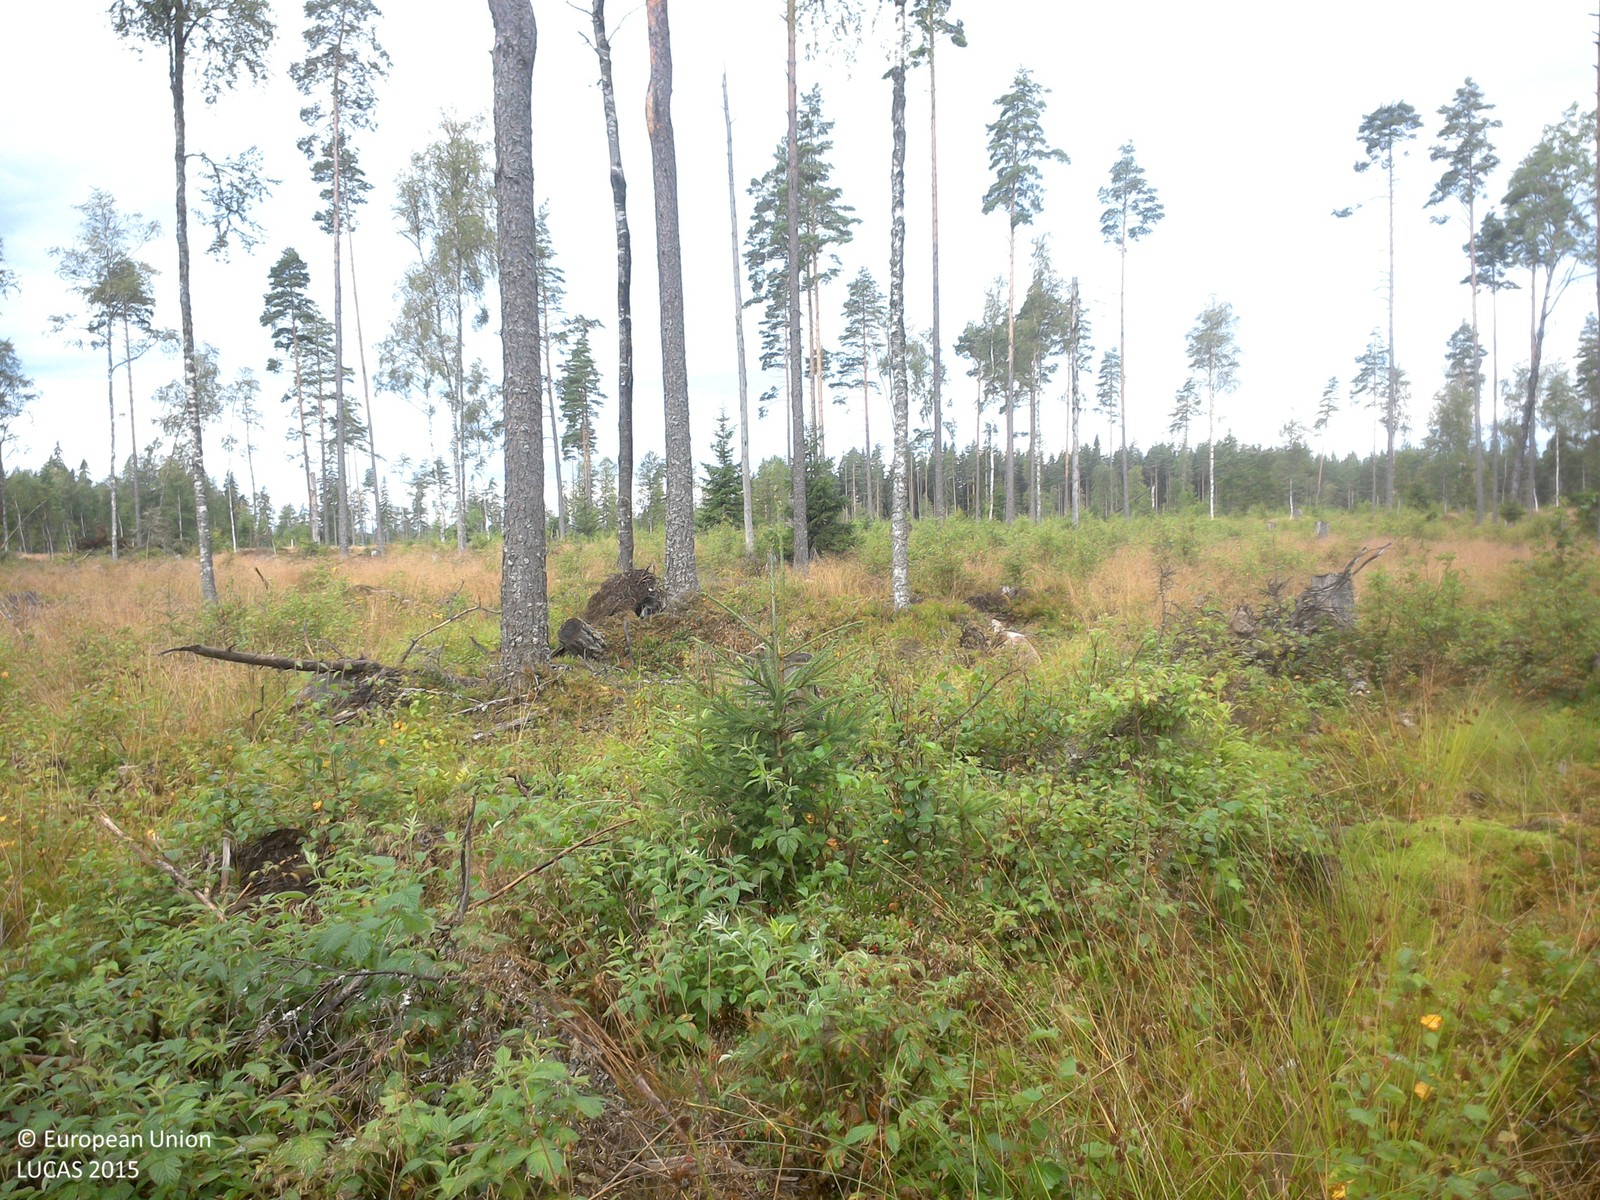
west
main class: Woodland
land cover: Pine dominated coniferous woodland
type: boreal forest
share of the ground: 10 - 25 %
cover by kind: herbaceous plants 70 %, lichens and mosses 20 %, coniferous forest trees 10 %
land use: Forestry
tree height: > 5 m
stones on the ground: < 10 %
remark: Clear cut
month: August
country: SE
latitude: 57.7396
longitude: 15.2198
